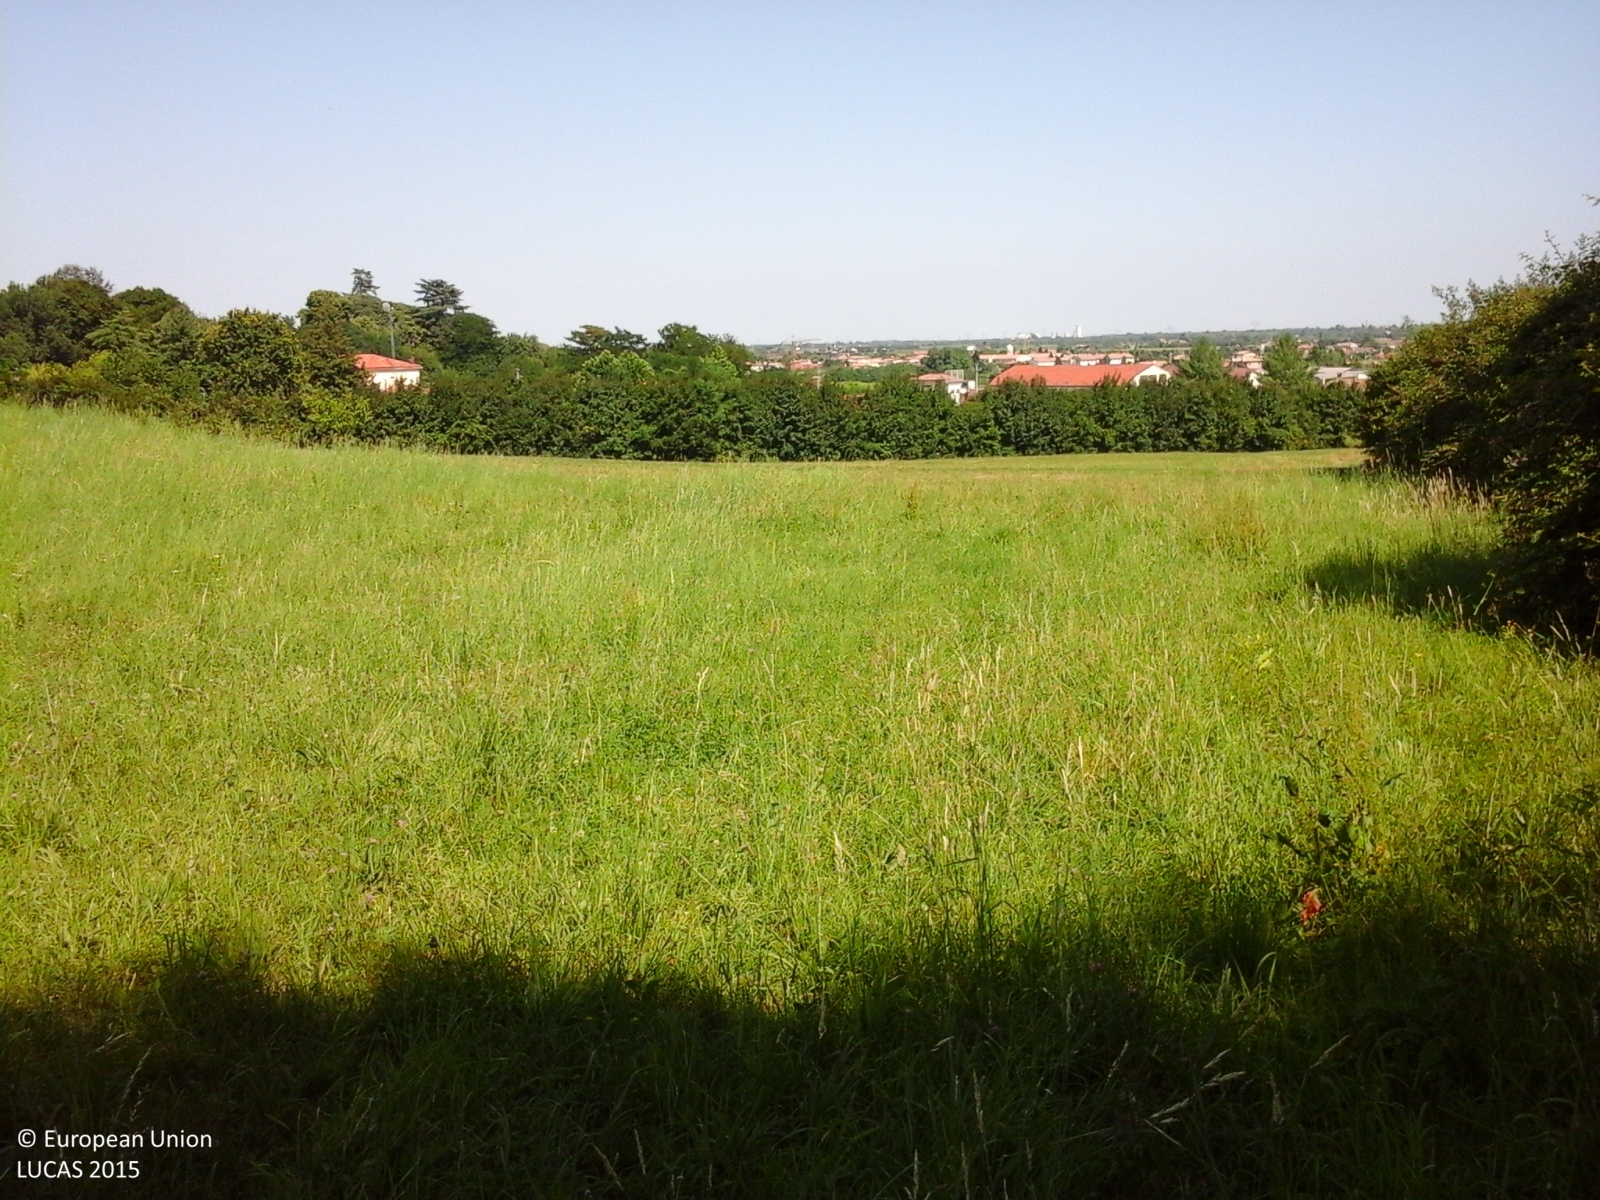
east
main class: Grassland
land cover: Grassland without tree/shrub cover
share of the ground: > 75 %
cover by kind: herbaceous plants 100 %
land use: Agriculture (excluding fallow land and kitchen gardens)
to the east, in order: Grassland without tree/shrub cover; Abandoned hedges; Electric lines; Paved roads, cycling and walking lanes; Grassland without tree/shrub cover; Artificial constructions in urban areas
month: July
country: IT
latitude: 45.8066
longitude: 12.1715
